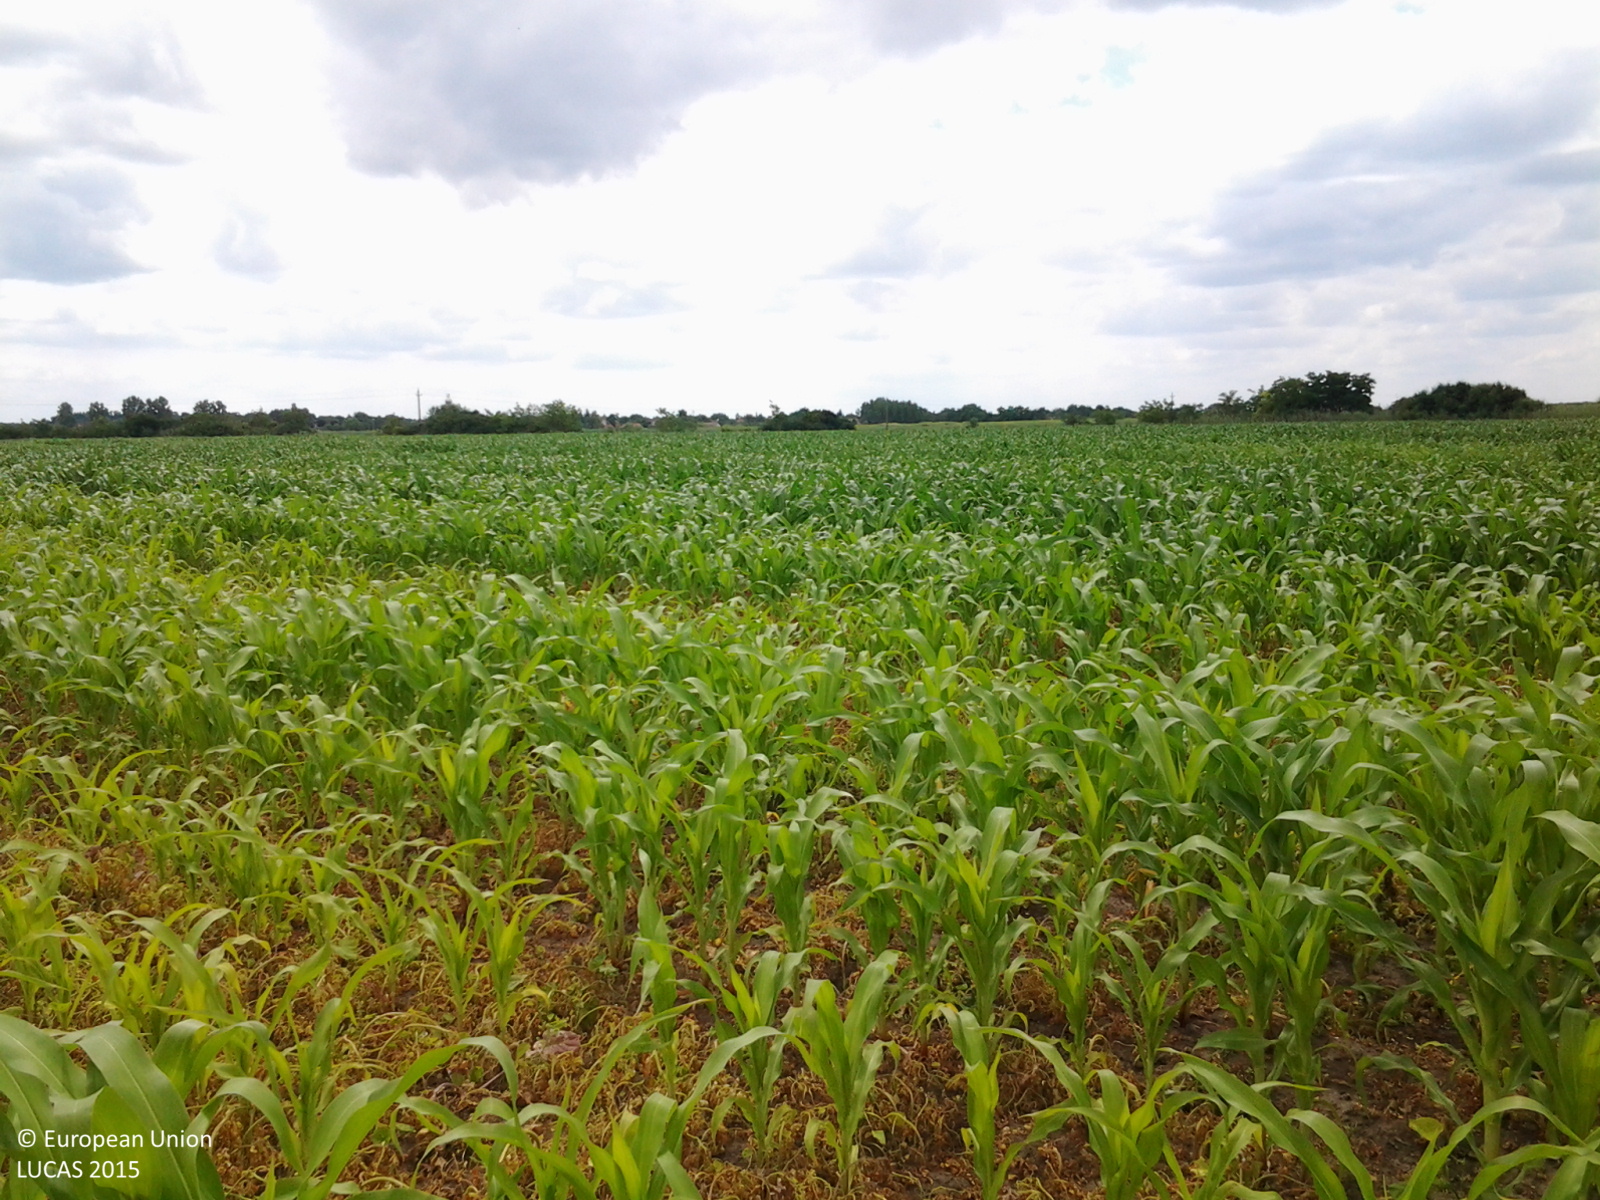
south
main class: Cropland
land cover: Maize
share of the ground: > 75 %
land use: Agriculture (excluding fallow land and kitchen gardens)
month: June
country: HU
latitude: 46.5620
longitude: 21.1879
